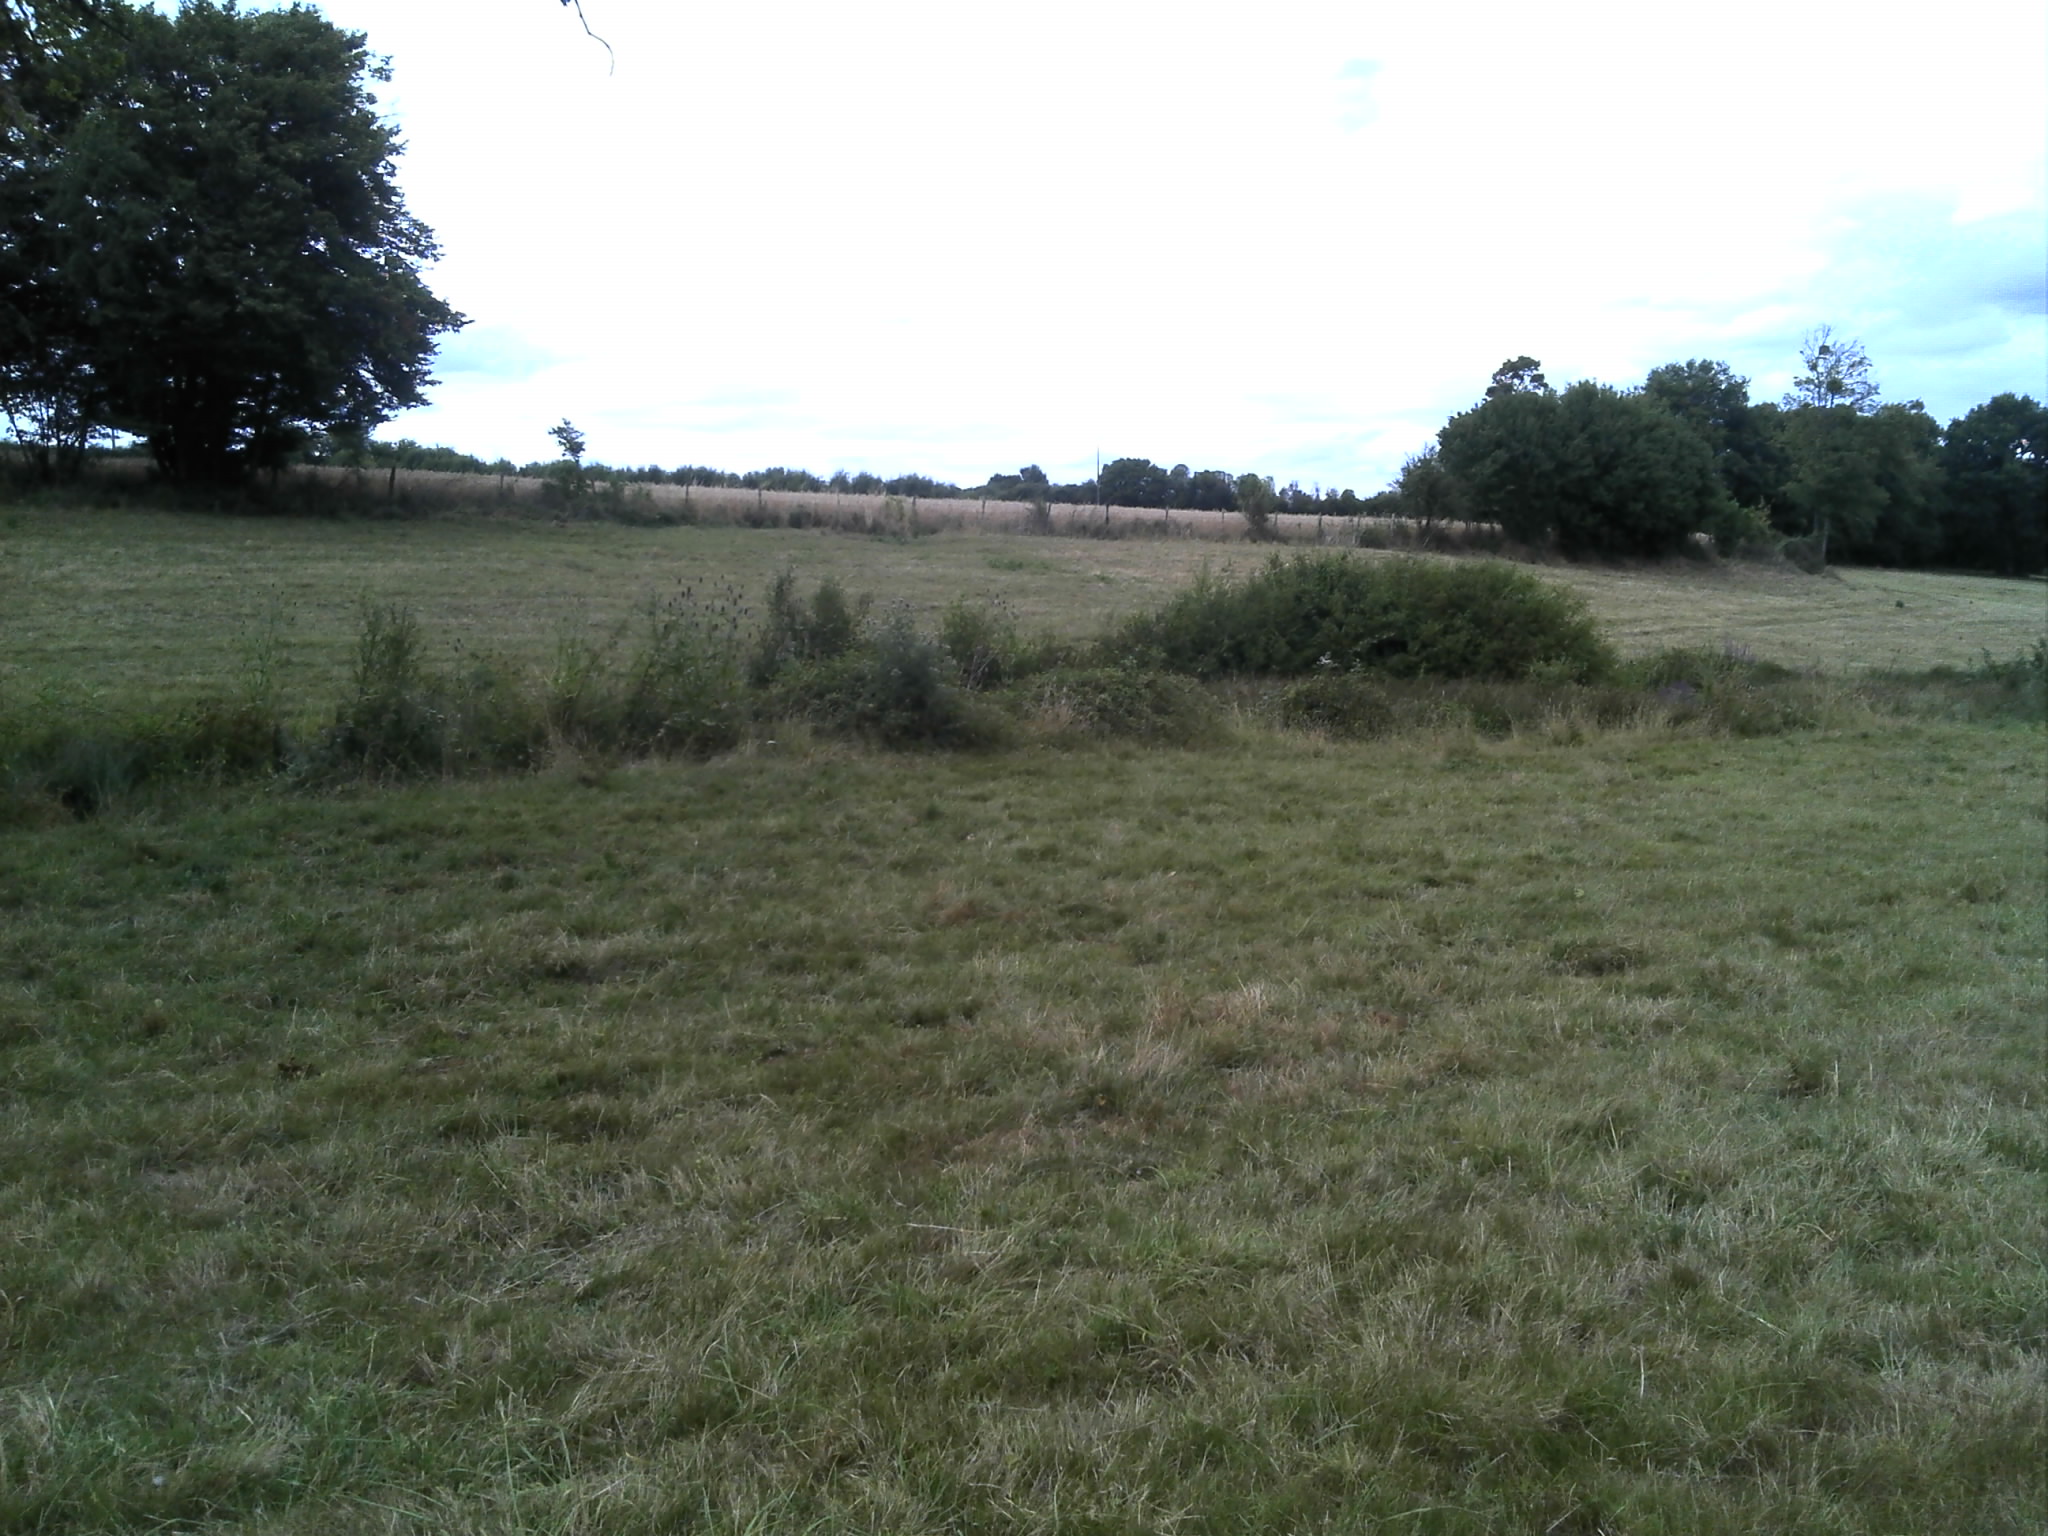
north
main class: Grassland
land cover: Grassland with sparse tree/shrub cover
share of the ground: > 75 %
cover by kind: herbaceous plants 95 %, broadleaved forest trees 5 %
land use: Agriculture (excluding fallow land and kitchen gardens)
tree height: > 5 m
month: July
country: FR
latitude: 46.5217
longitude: 1.5298
